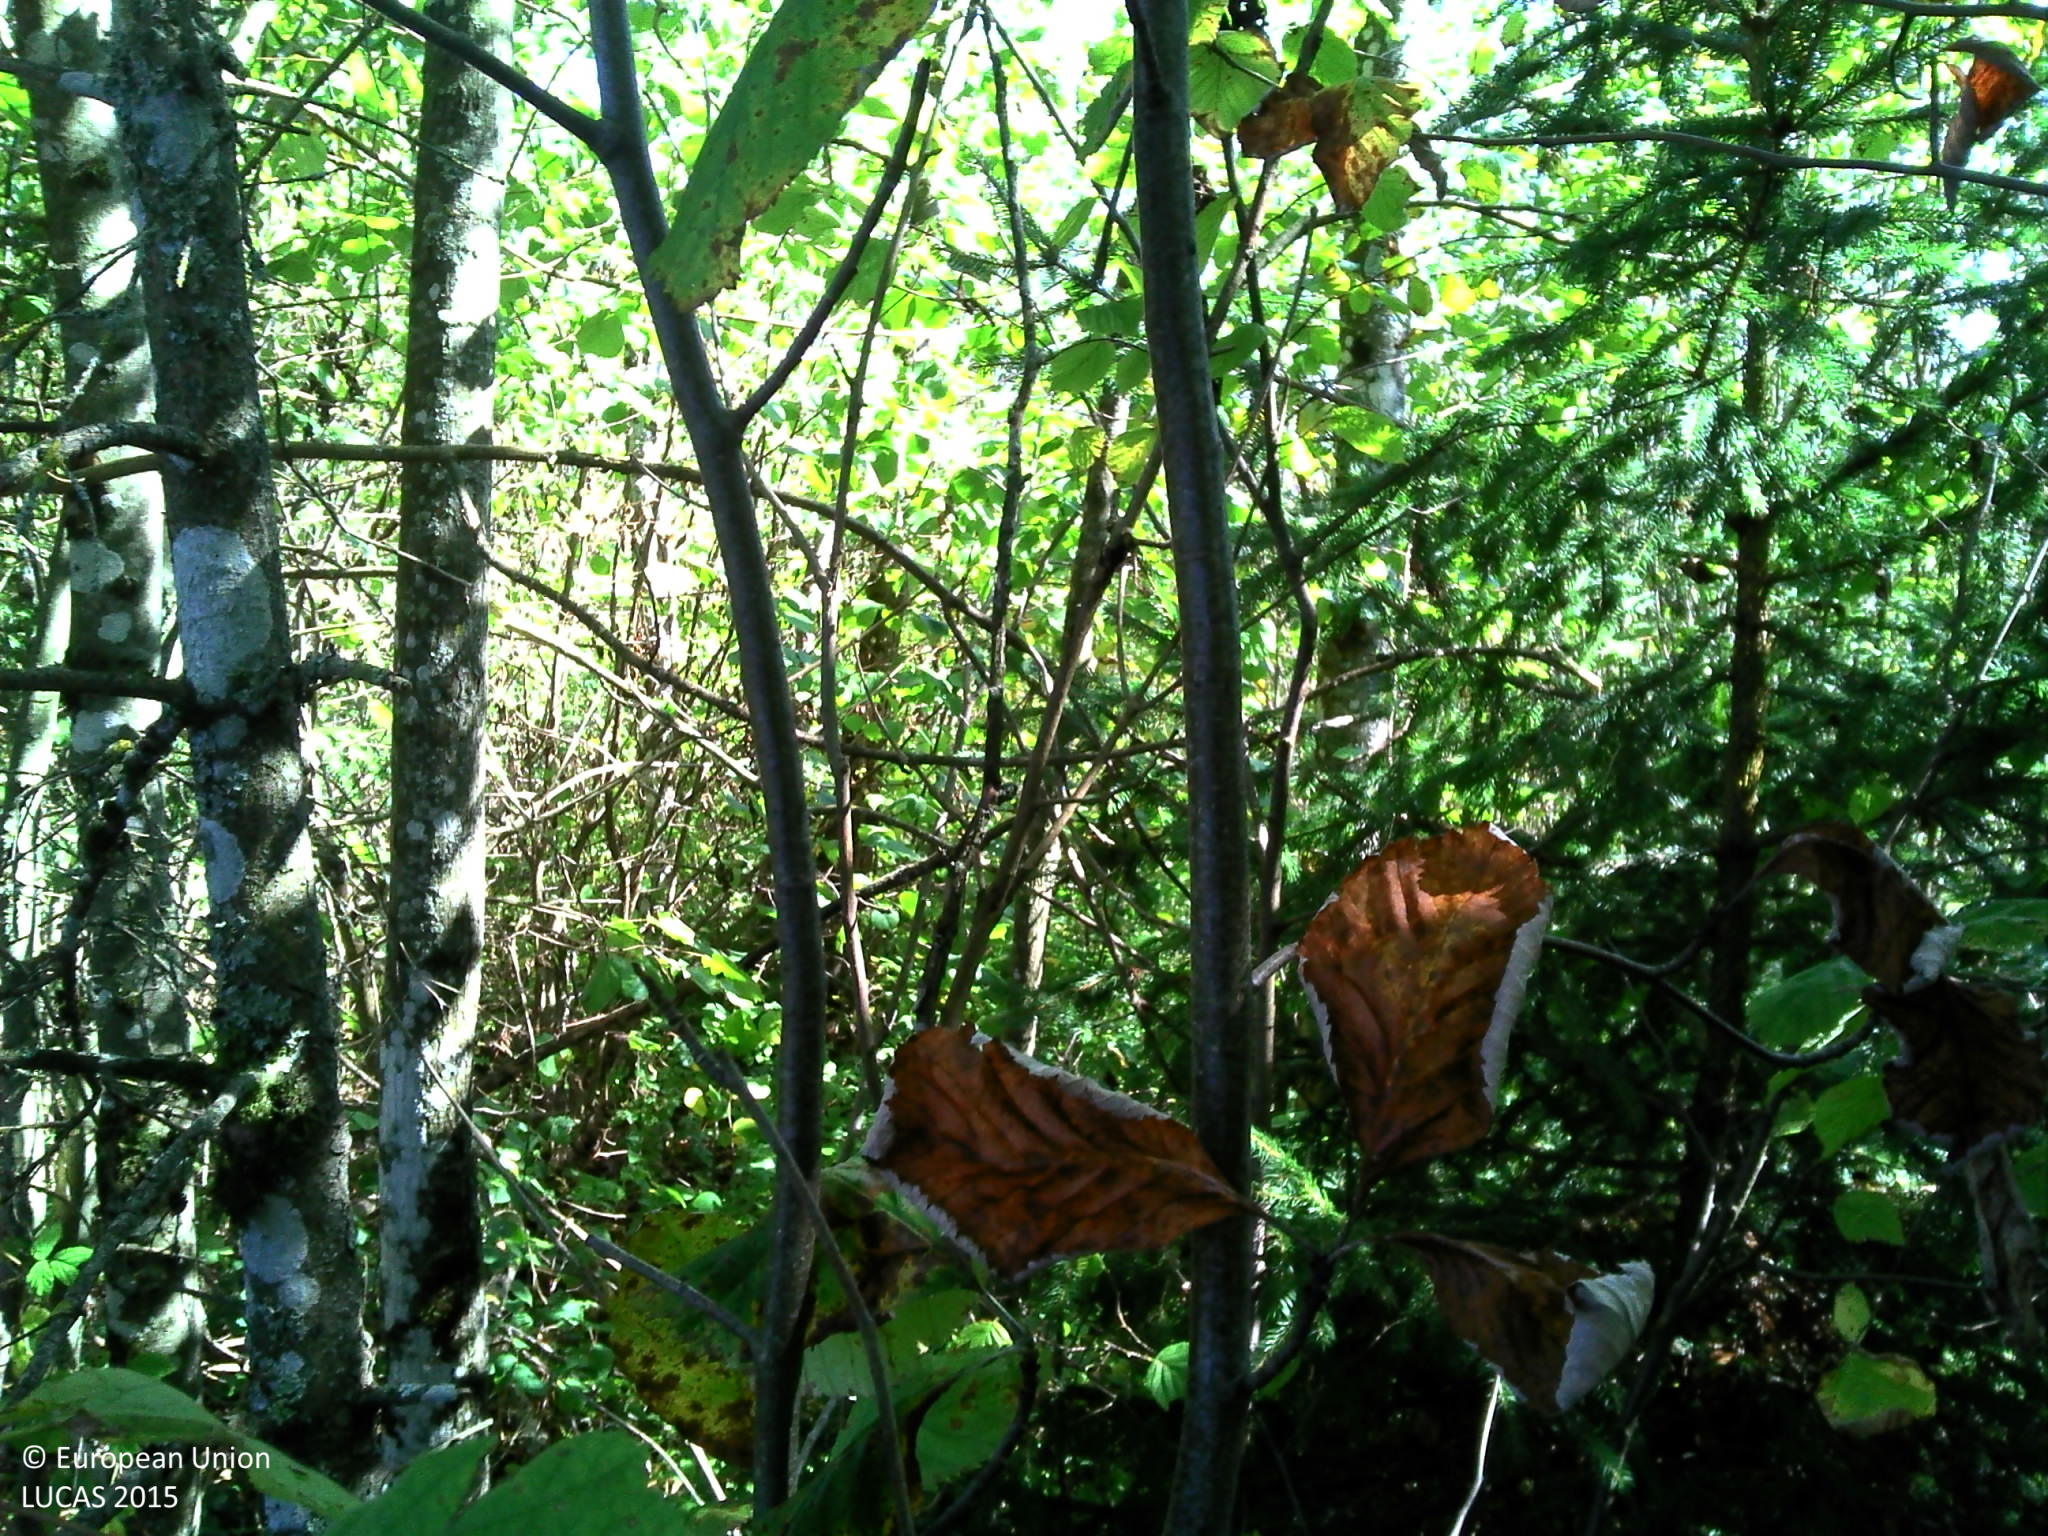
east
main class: Grassland
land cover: Grassland without tree/shrub cover
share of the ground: > 75 %
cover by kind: herbaceous plants 100 %
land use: Agriculture (excluding fallow land and kitchen gardens)
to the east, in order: Grassland without tree/shrub cover; Fences; Broadleaved woodland; Grassland without tree/shrub cover; Electric lines; Fences; Other bare soil; Grassland without tree/shrub cover
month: September
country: FR
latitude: 47.2238
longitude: 6.8457
